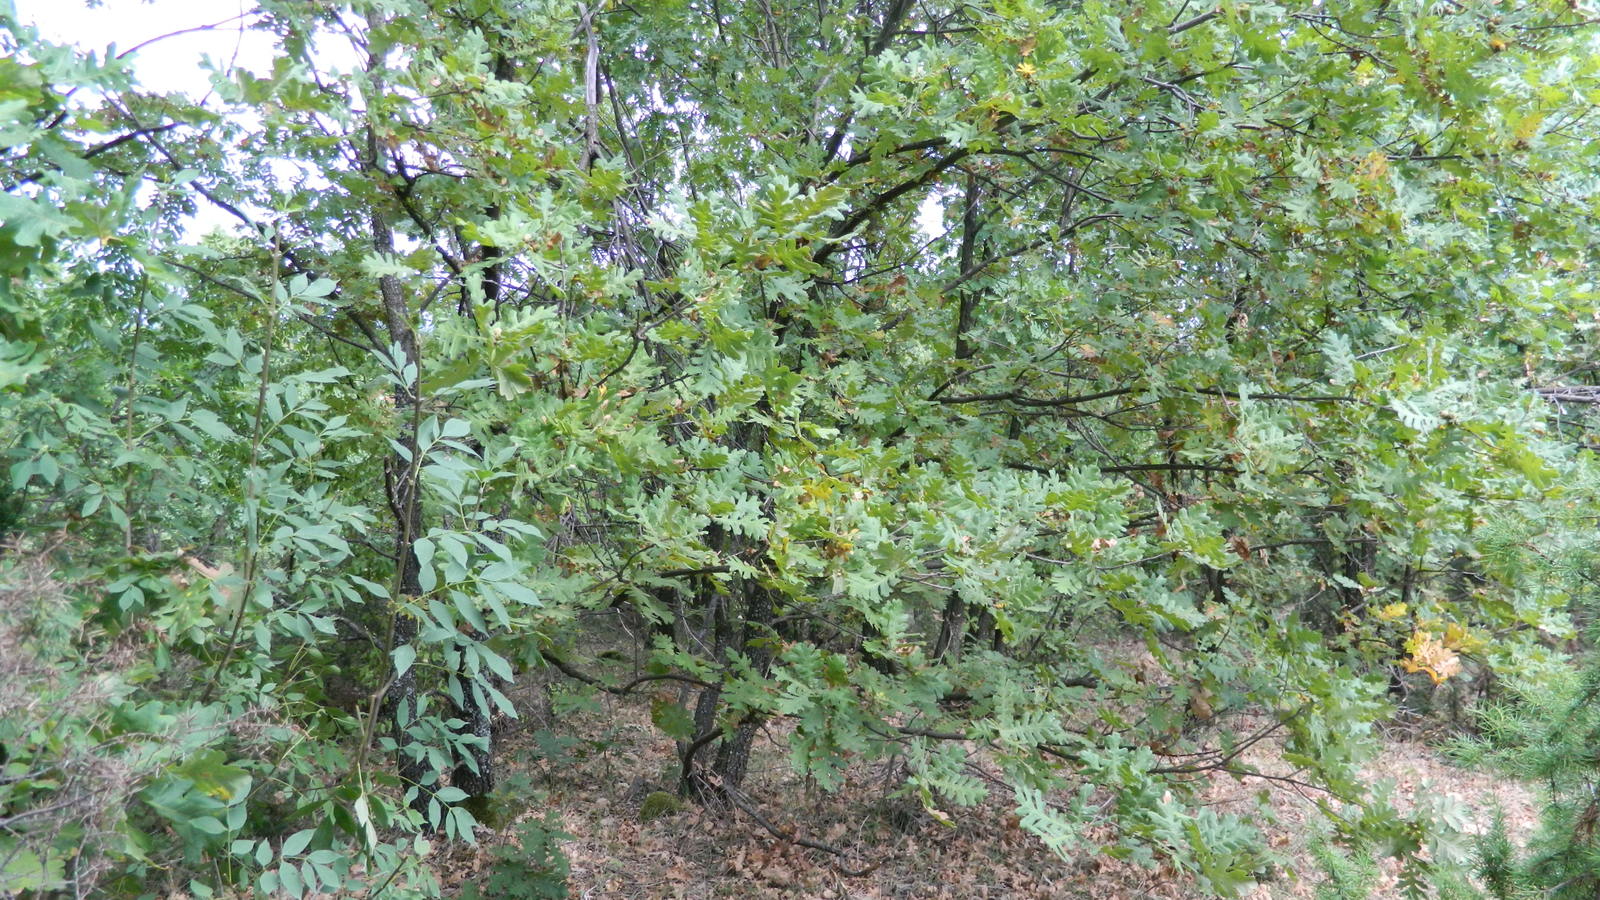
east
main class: Woodland
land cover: Broadleaved woodland
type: mesophytic deciduous forest
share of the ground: > 75 %
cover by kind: broadleaved forest trees 80 %, unconsolidated bare surface 15 %, shrubs 5 %
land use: Forestry
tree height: > 5 m
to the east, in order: Broadleaved woodland; Tracks; Broadleaved woodland; Rivers and streams; Broadleaved woodland; Tracks; Other mixed woodland; Rivers and streams; Pine dominated mixed woodland
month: August
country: BG
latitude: 41.6956
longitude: 25.8192
